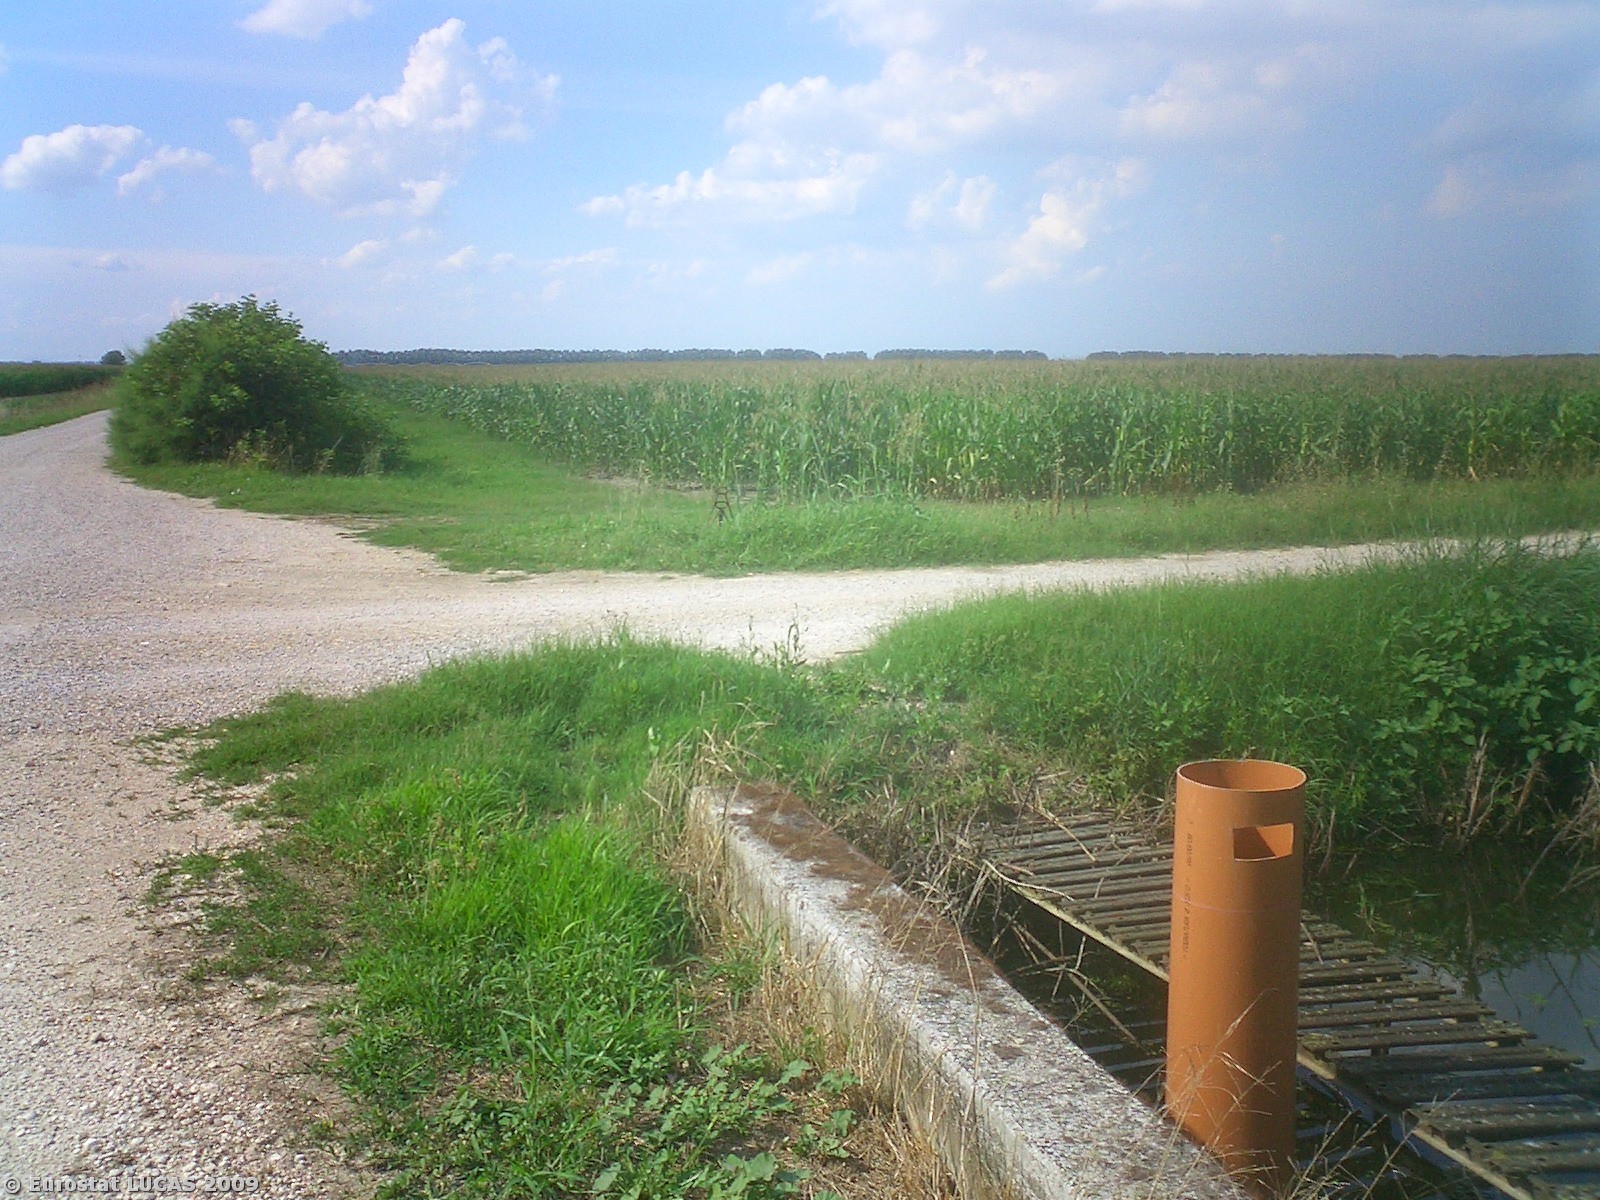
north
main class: Cropland
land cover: Rice
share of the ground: > 75 %
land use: Agriculture (excluding fallow land and kitchen gardens)
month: July
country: IT
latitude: 44.7451
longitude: 12.0547
